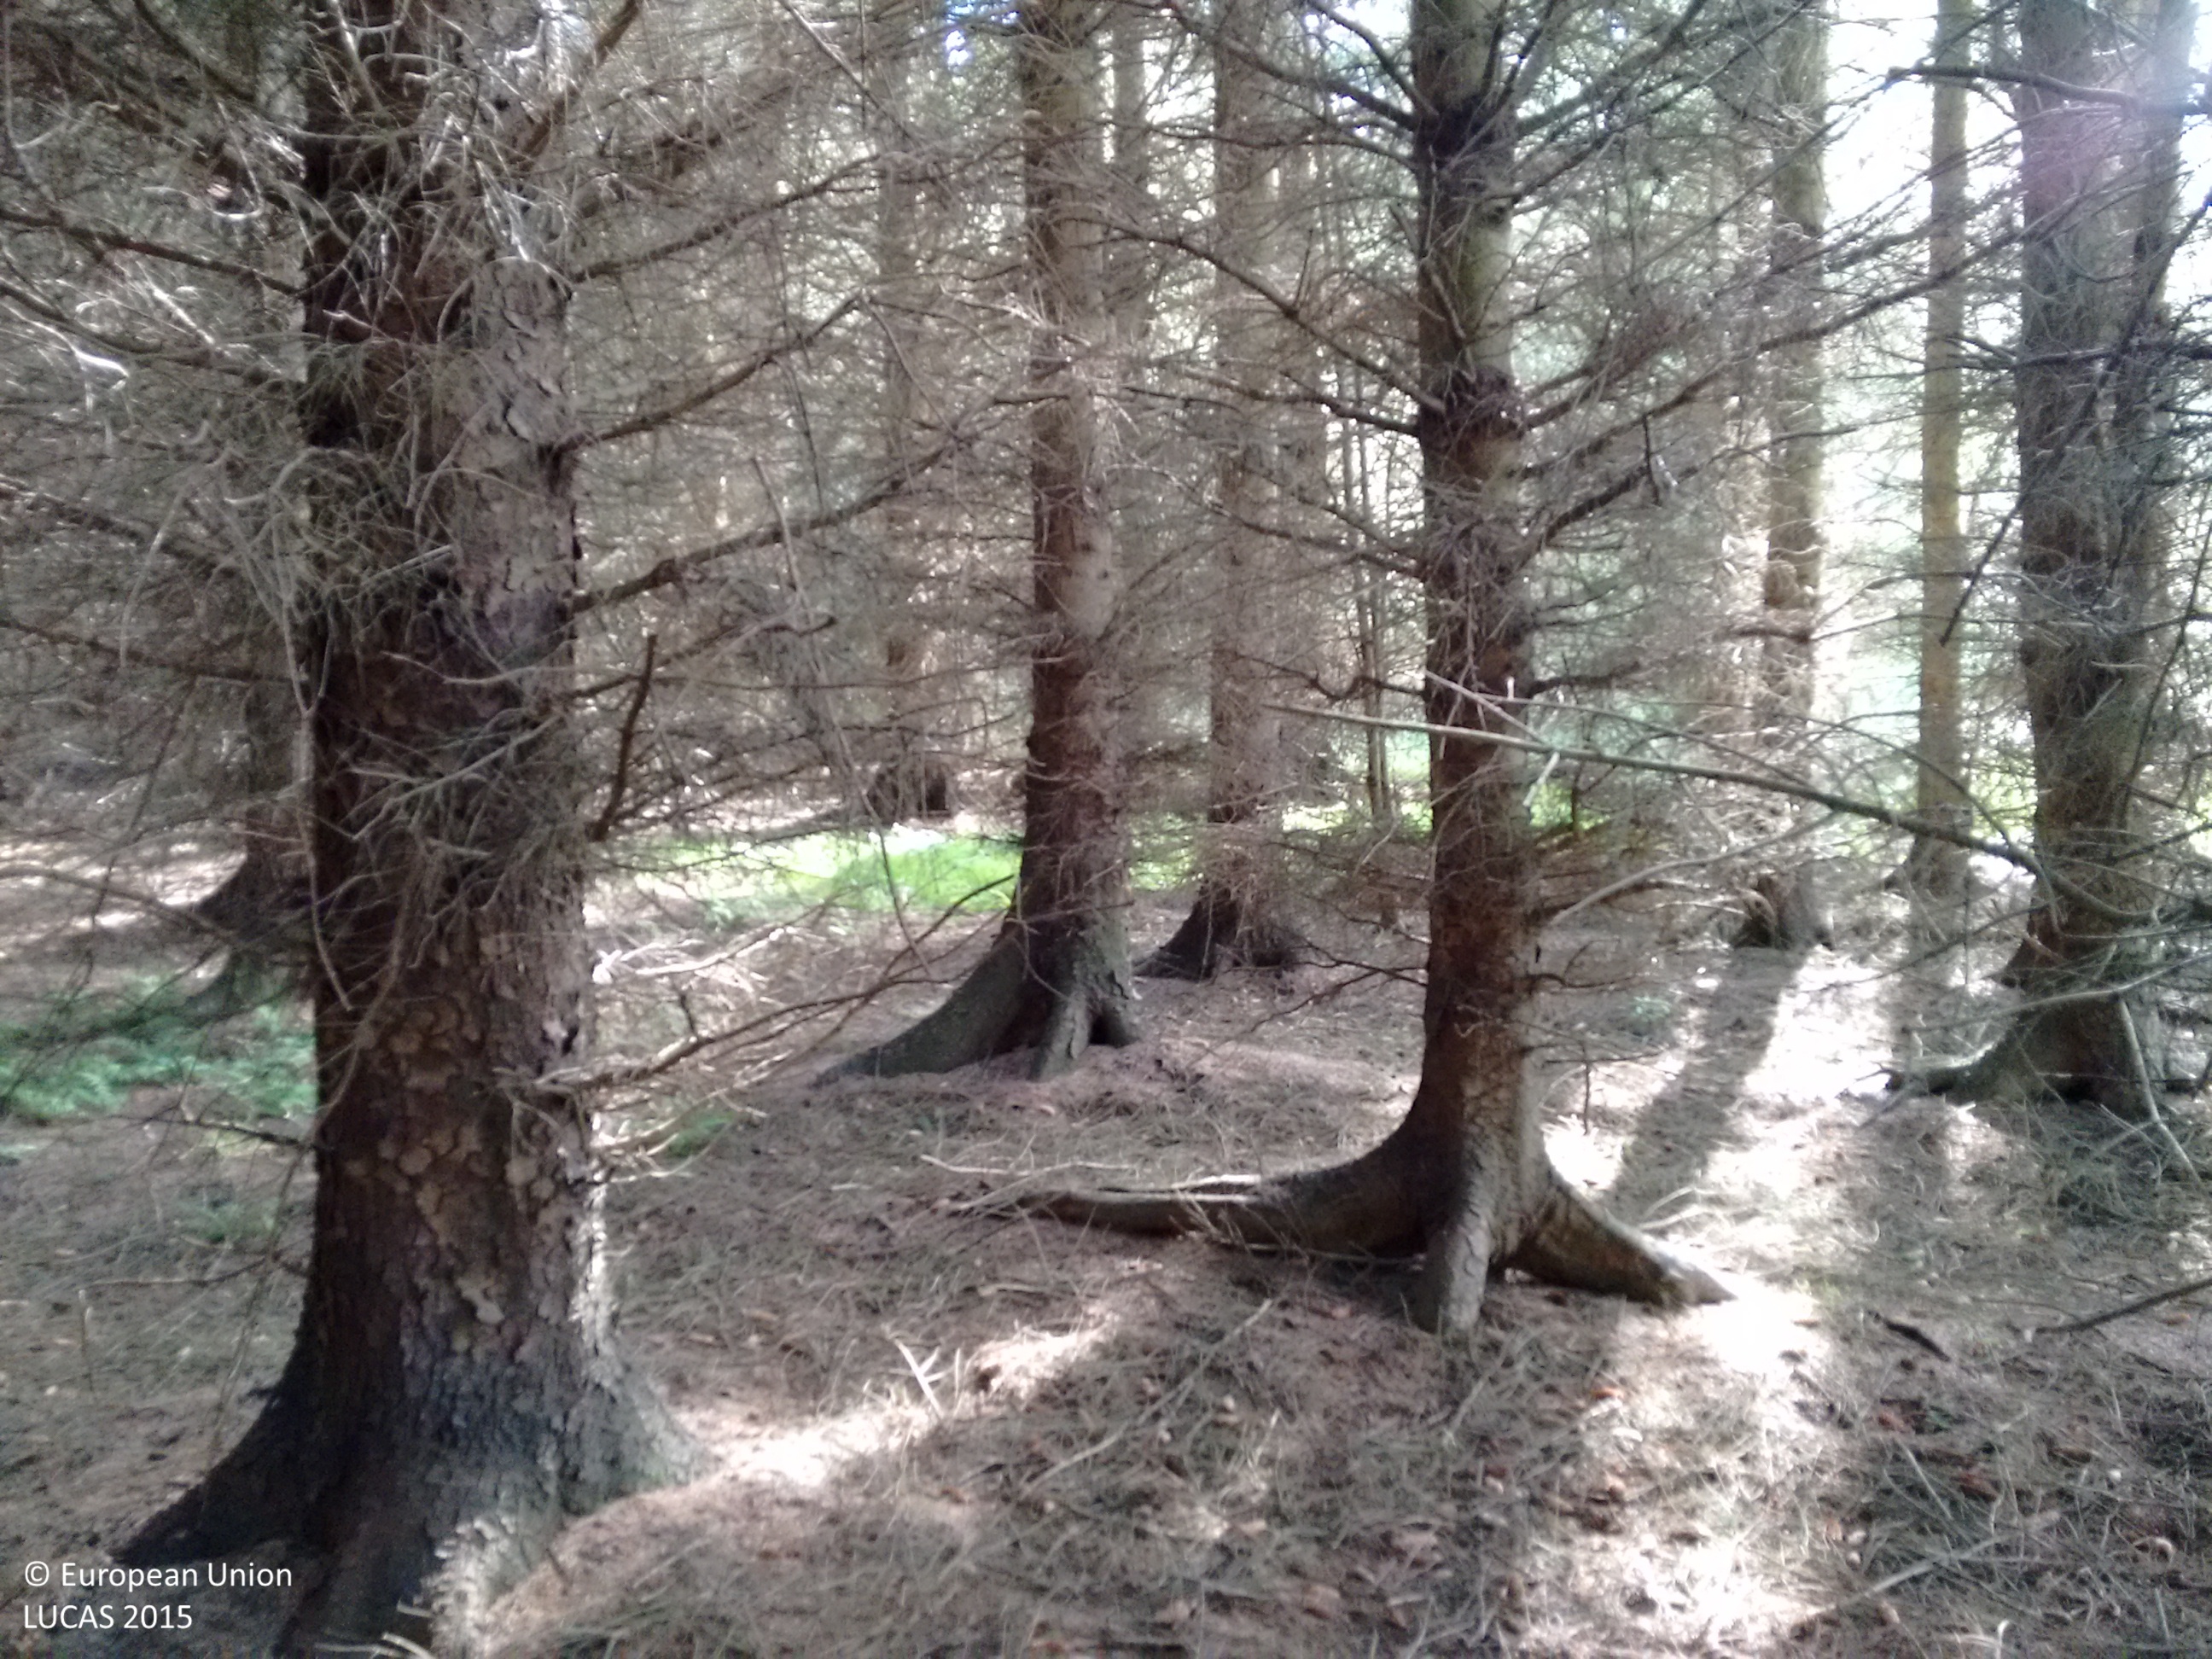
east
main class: Woodland
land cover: Spruce dominated coniferous woodland
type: exotic forest
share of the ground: > 75 %
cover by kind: coniferous forest trees 100 %
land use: Forestry
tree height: > 5 m
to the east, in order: Spruce dominated coniferous woodland; Spontaneously vegetated surfaces; Paved roads, cycling and walking lanes; Spontaneously vegetated surfaces; Spruce dominated coniferous woodland; Grassland without tree/shrub cover; Other mixed woodland; Spruce dominated coniferous woodland
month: July
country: GB
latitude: 54.9257
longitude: -4.4408
